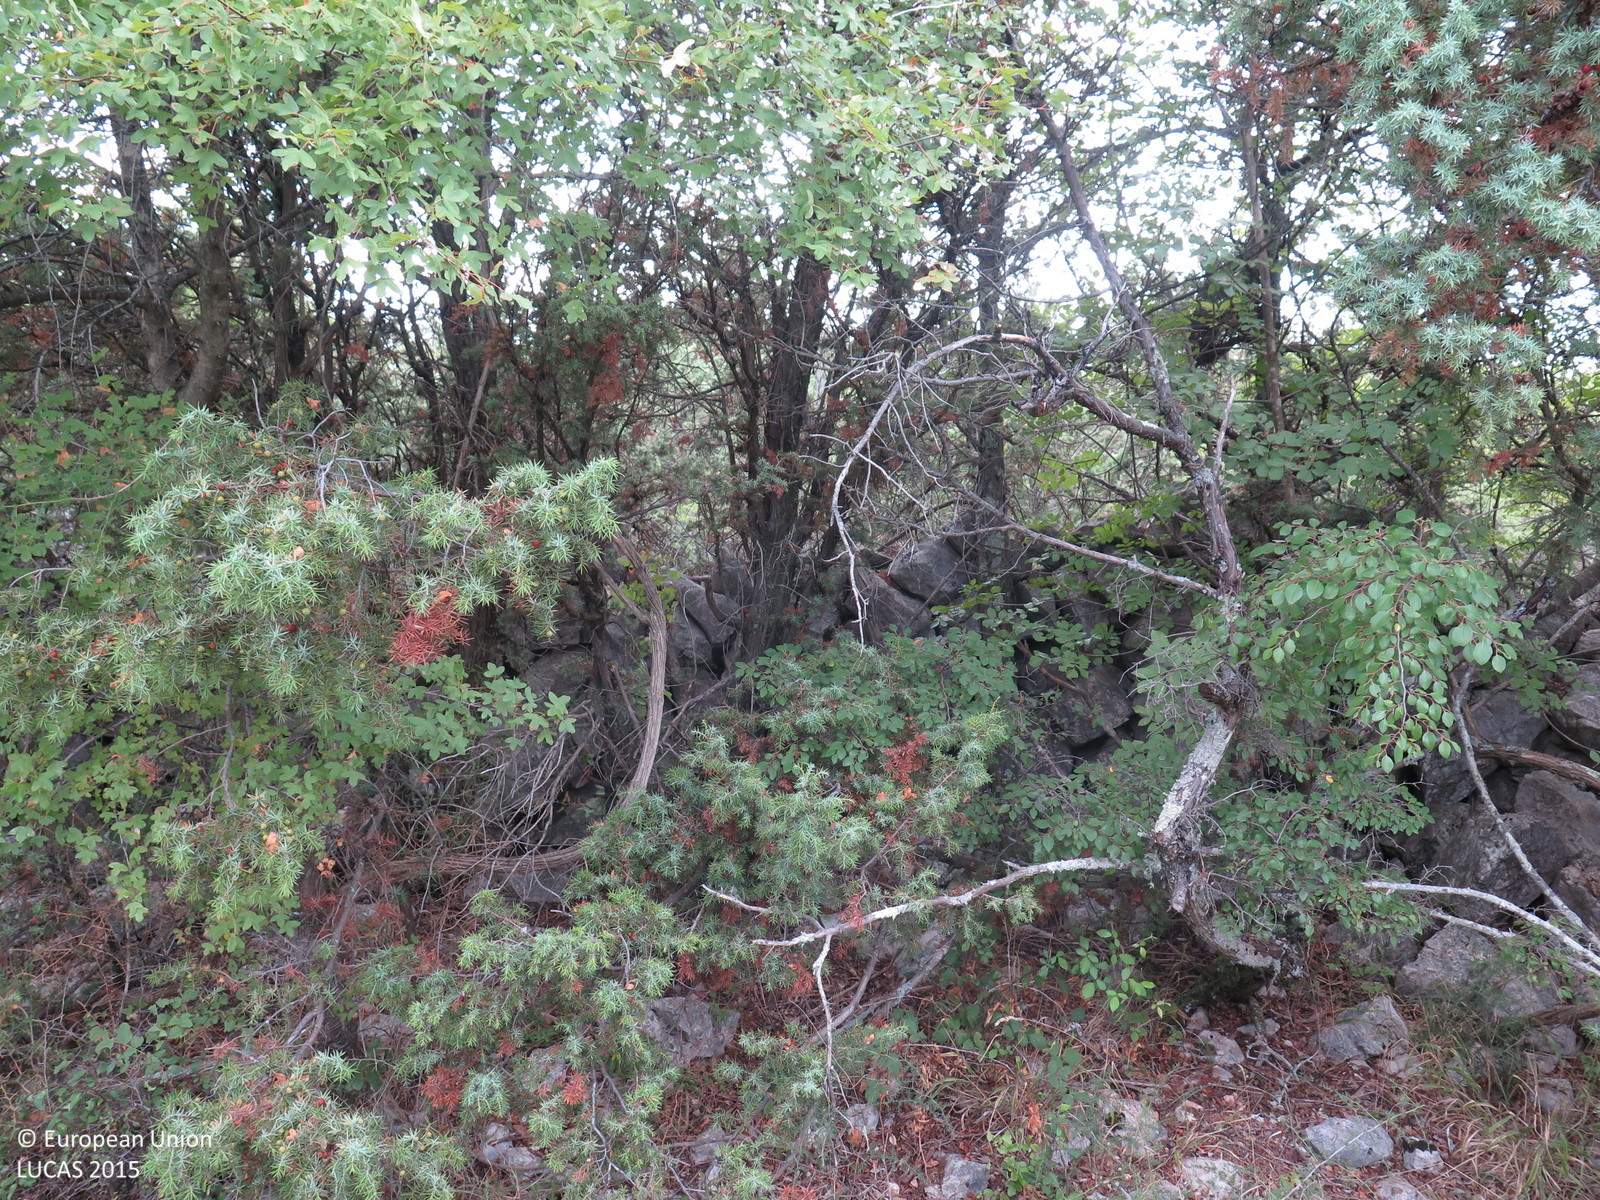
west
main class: Shrubland
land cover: Shrubland with sparse tree cover
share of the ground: > 75 %
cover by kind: shrubs 90 %, broadleaved forest trees 5 %, herbaceous plants 5 %
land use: Semi-natural and natural areas not in use
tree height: < 5 m
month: August
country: HR
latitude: 45.0599
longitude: 14.6296
